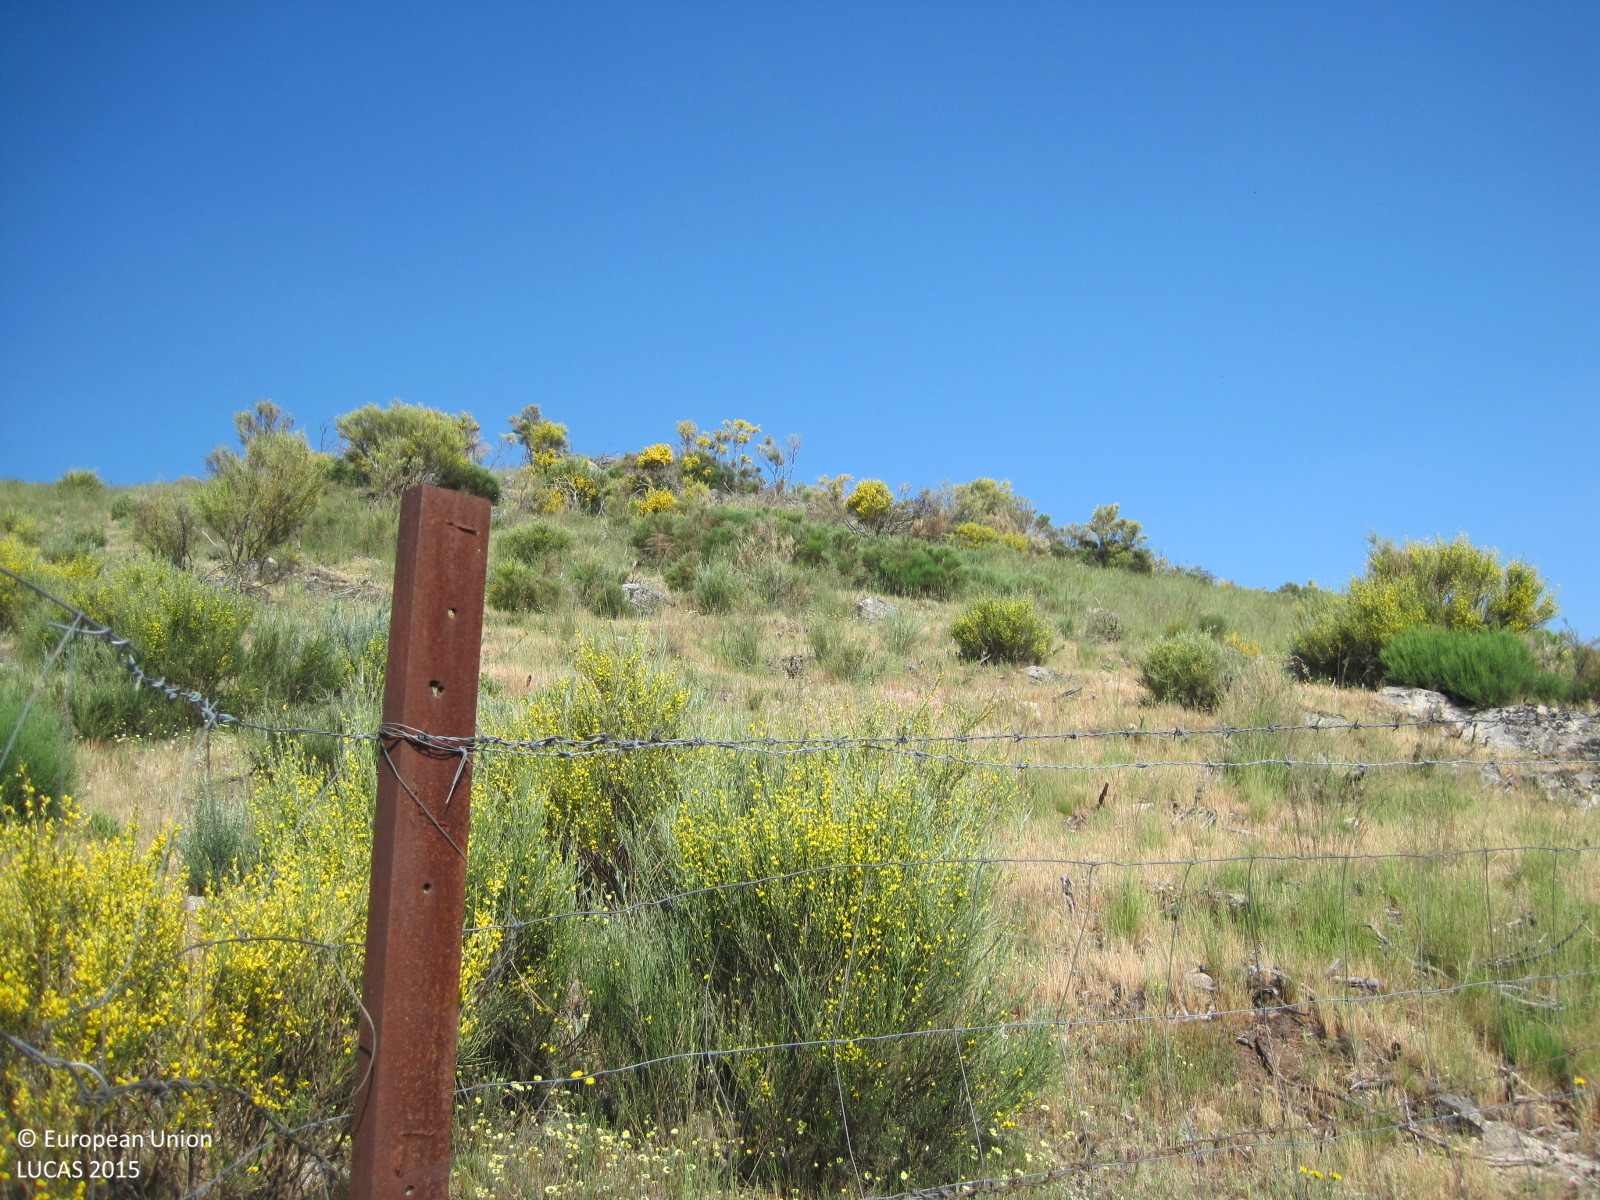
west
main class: Shrubland
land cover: Shrubland without tree cover
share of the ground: > 75 %
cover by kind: shrubs 100 %
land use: Agriculture (excluding fallow land and kitchen gardens)
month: June
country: ES
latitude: 40.3699
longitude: -5.0256
